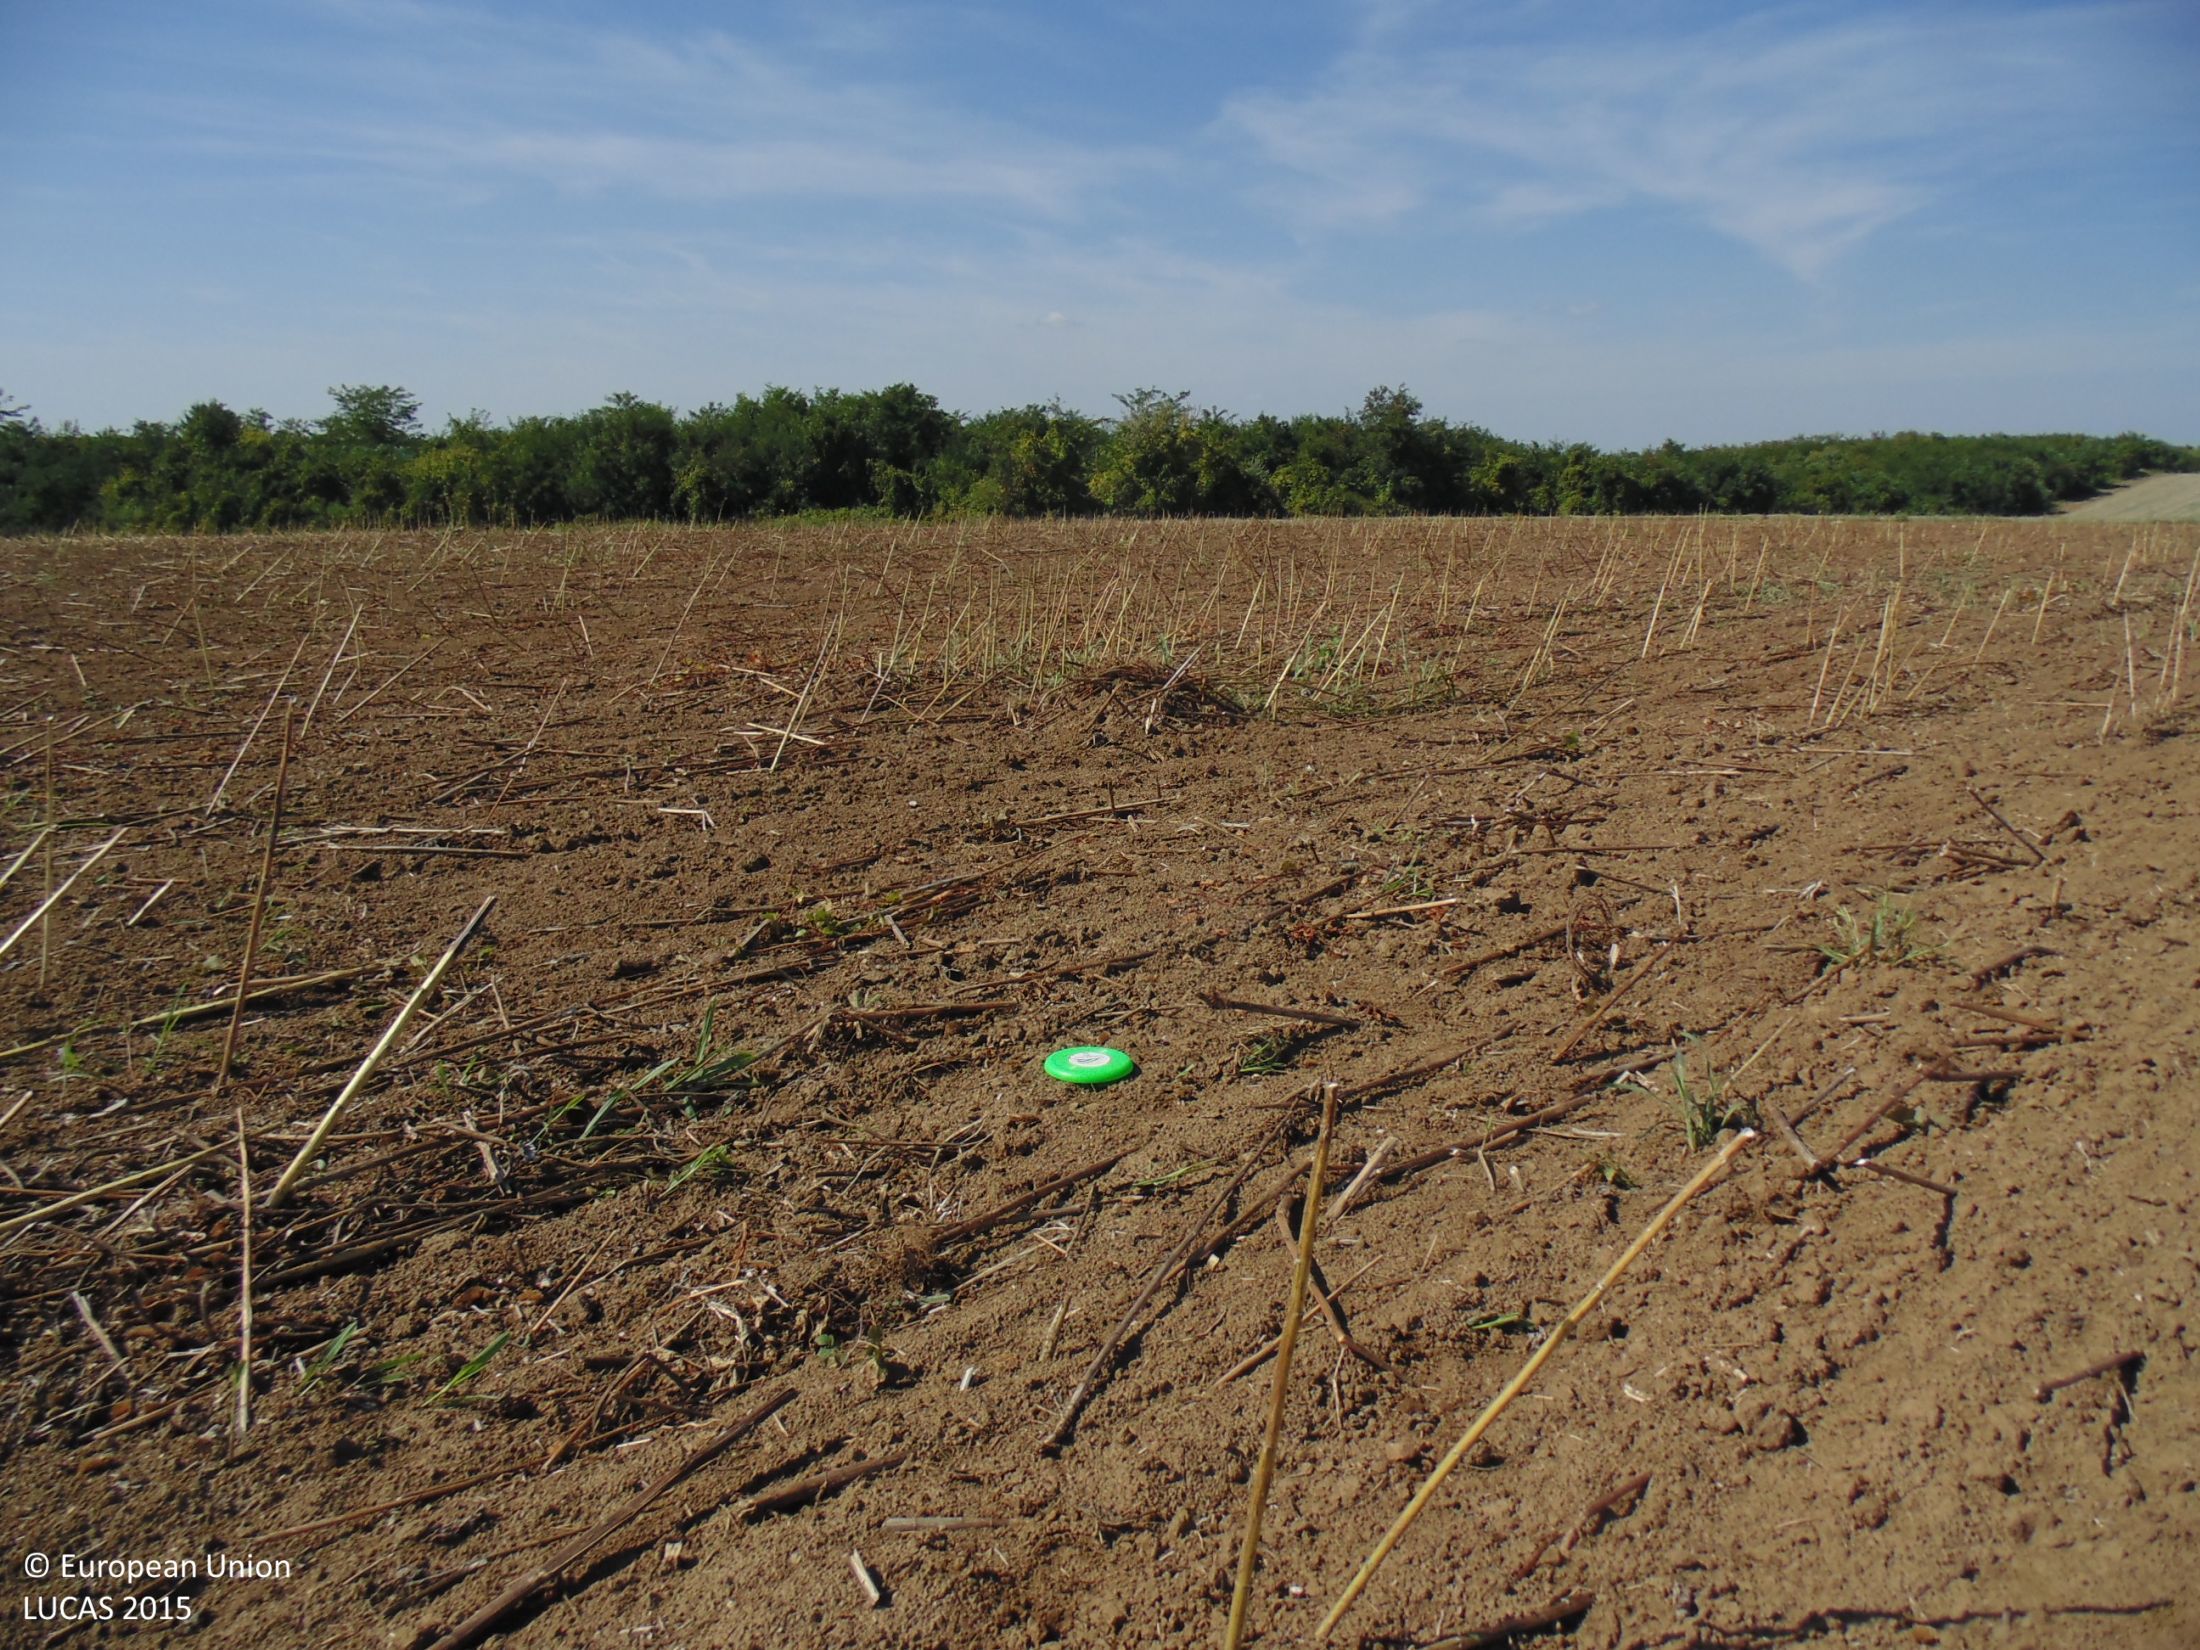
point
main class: Cropland
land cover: Sunflower
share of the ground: < 10 %
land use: Agriculture (excluding fallow land and kitchen gardens)
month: September
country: BG
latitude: 44.1068
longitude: 26.9260
